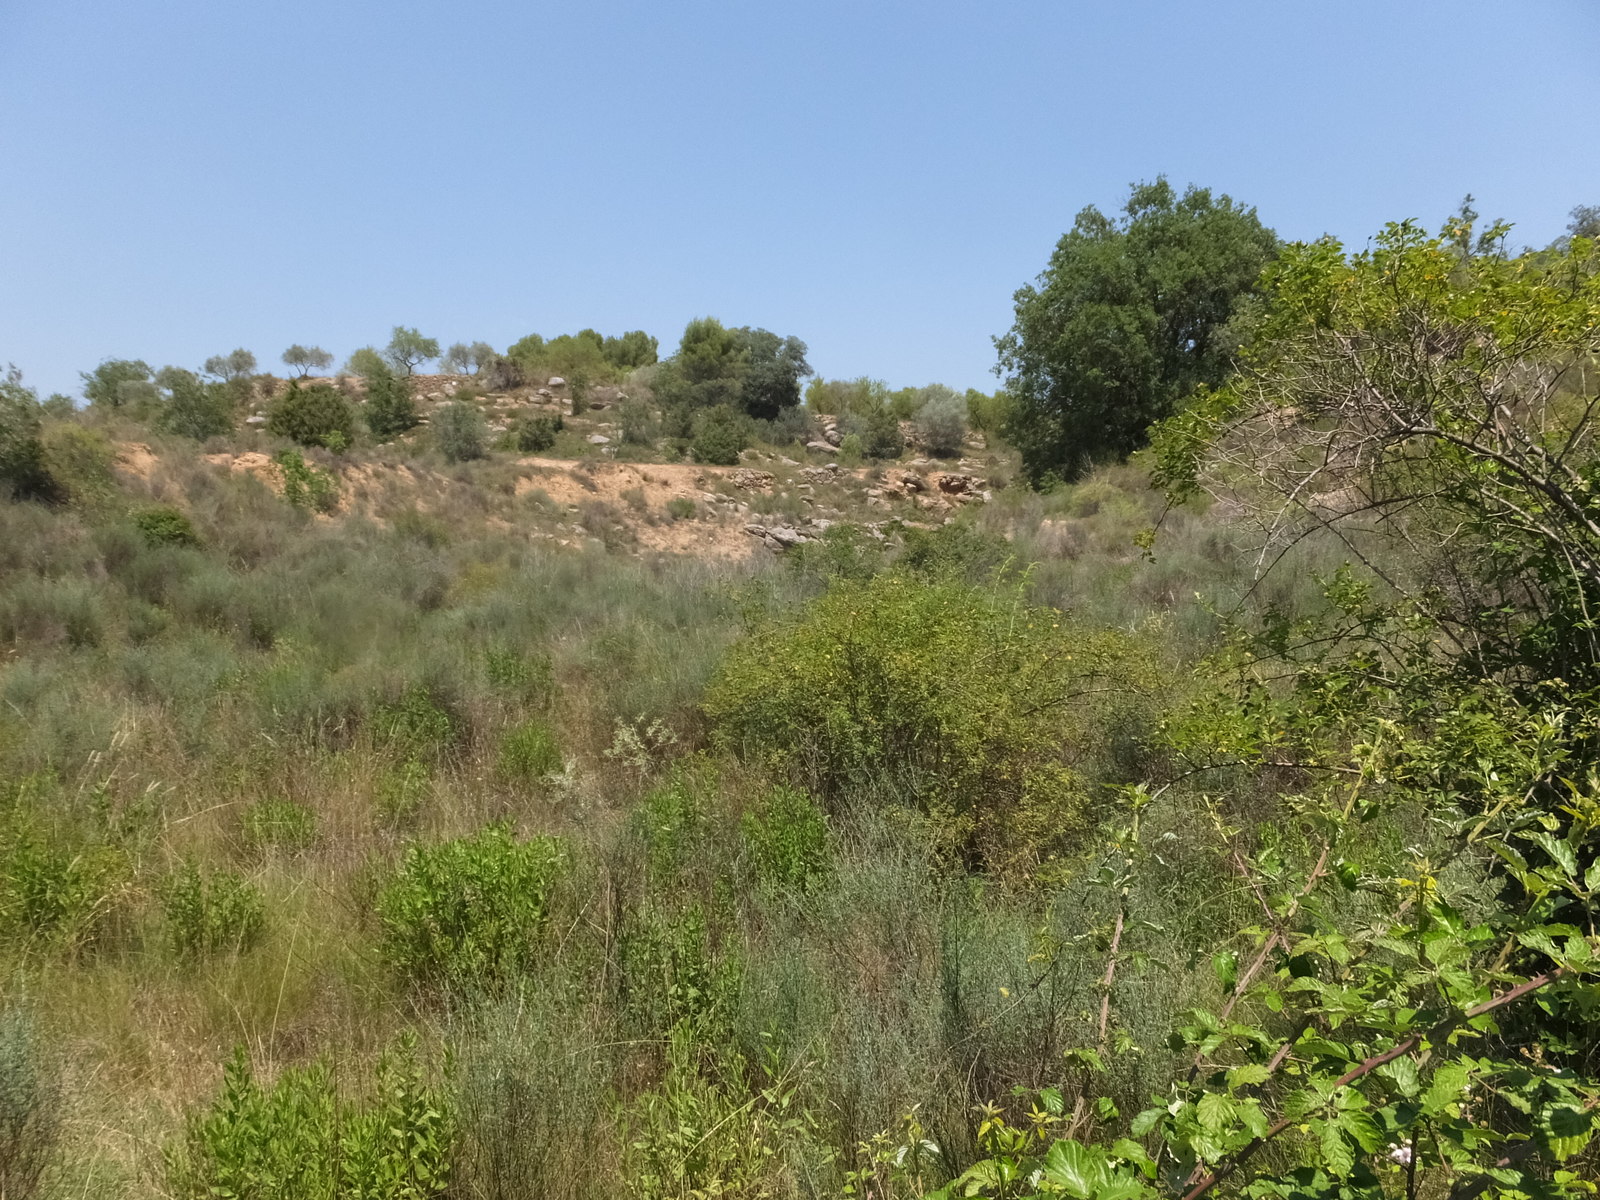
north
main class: Shrubland
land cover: Shrubland with sparse tree cover
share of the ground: 50 - 75 %
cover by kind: shrubs 70 %, herbaceous plants 25 %, broadleaved forest trees 5 %
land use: Semi-natural and natural areas not in use
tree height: < 5 m
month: June
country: ES
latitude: 41.9043
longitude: 0.5704
